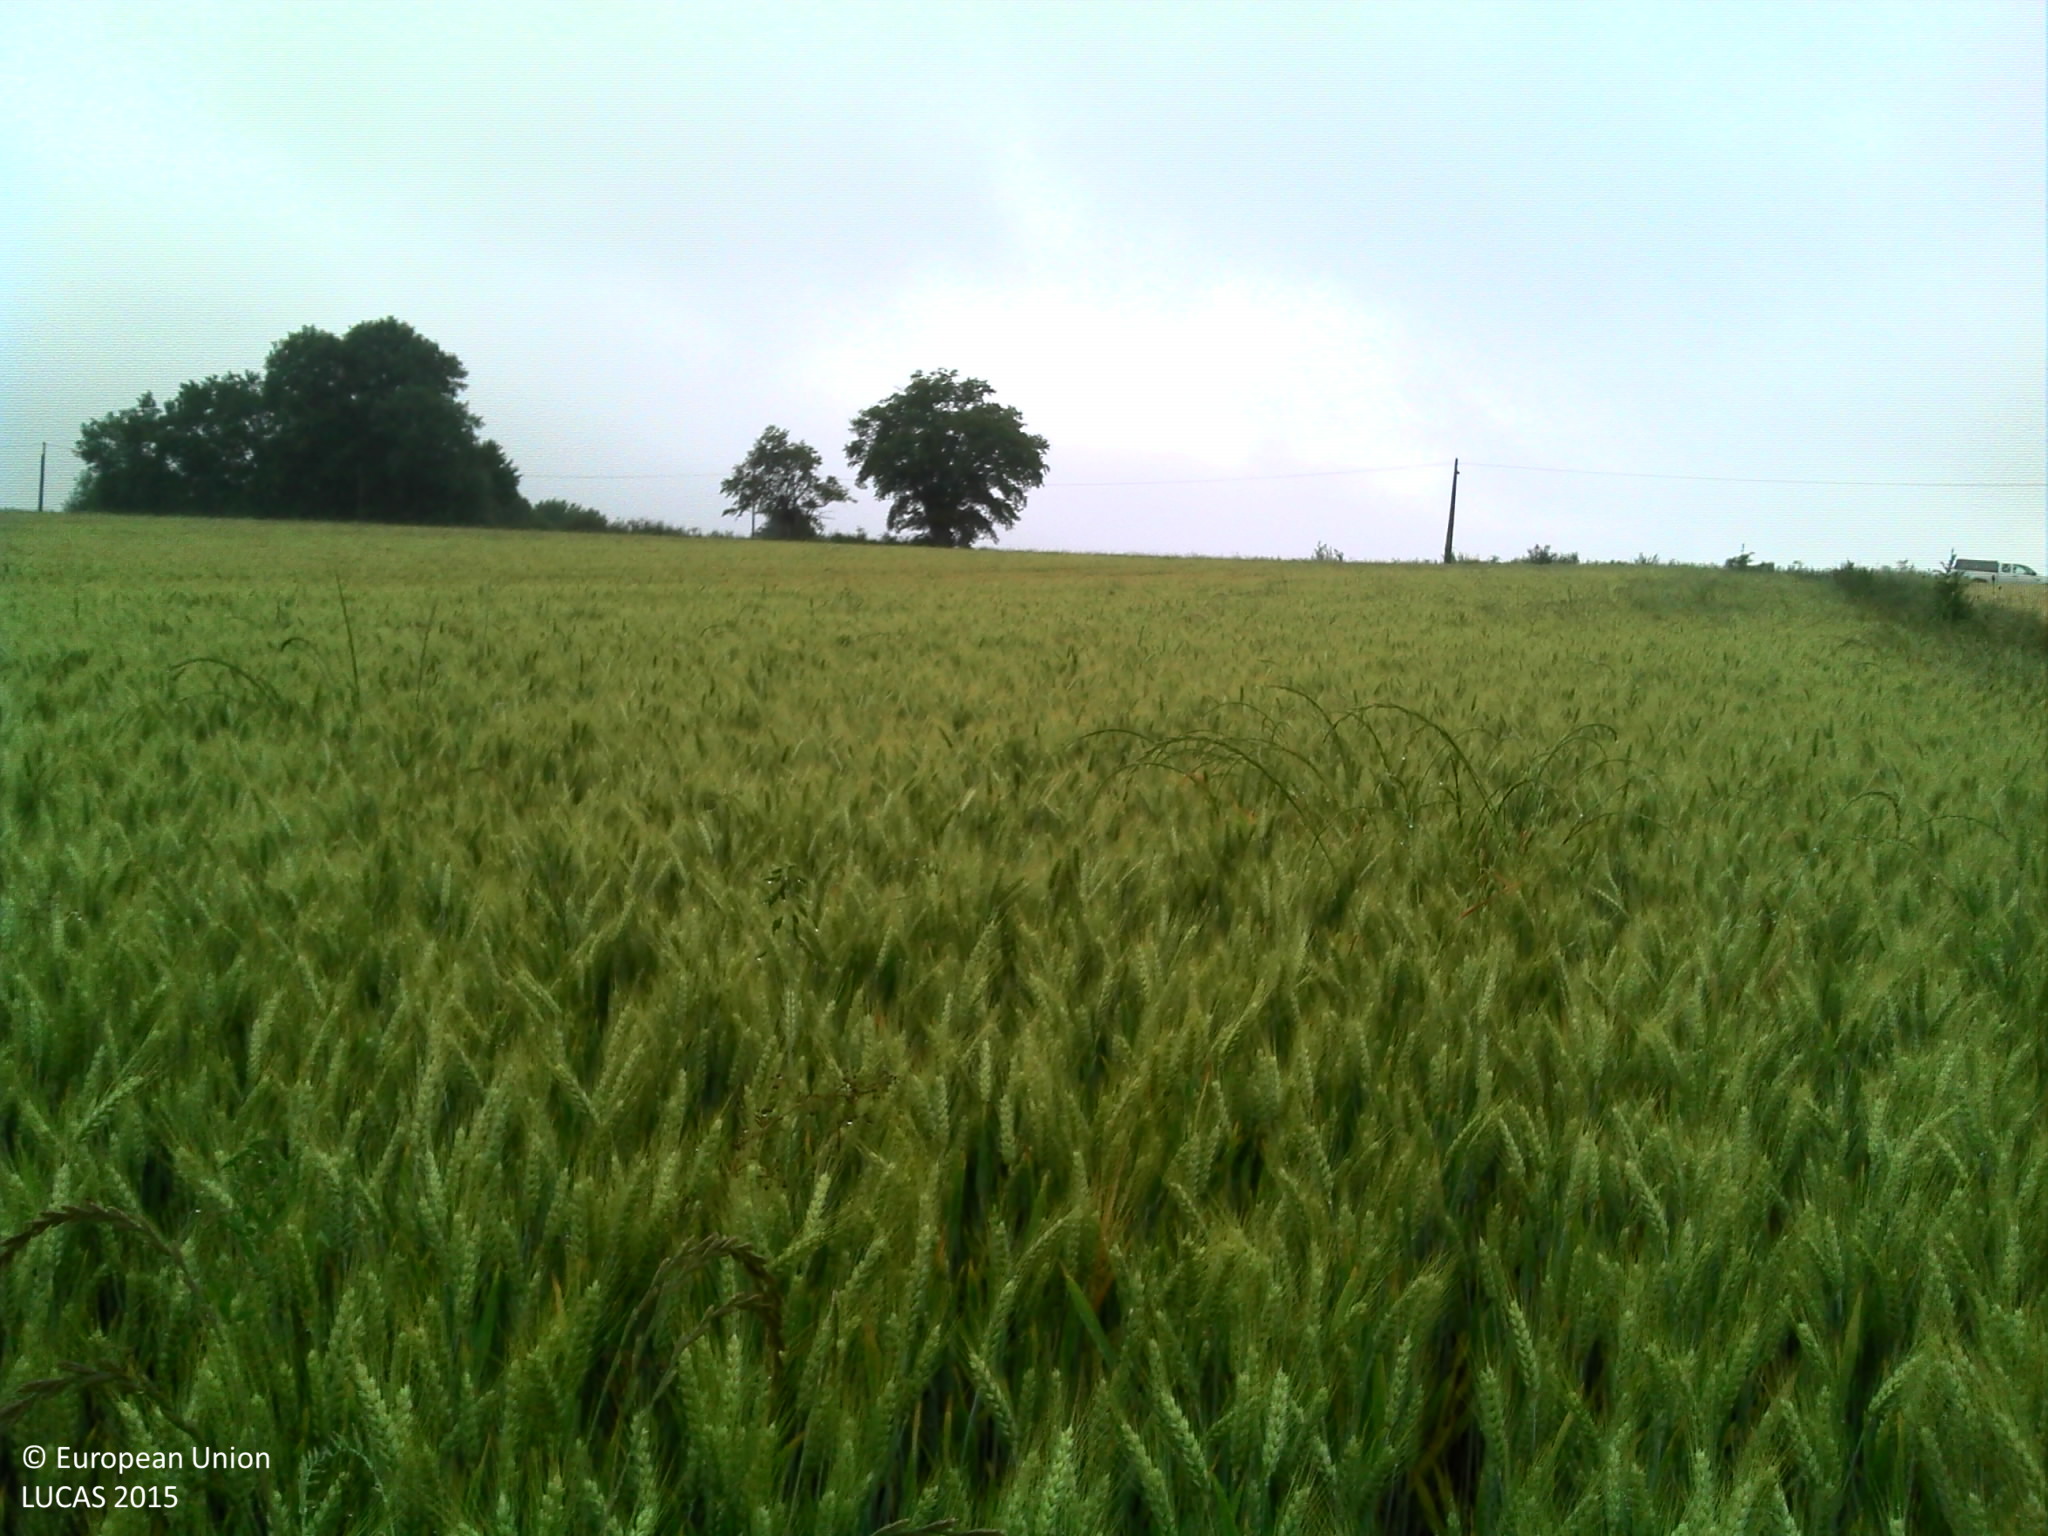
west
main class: Cropland
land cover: Common wheat
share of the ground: > 75 %
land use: Agriculture (excluding fallow land and kitchen gardens)
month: June
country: FR
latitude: 47.4724
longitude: 2.6554
